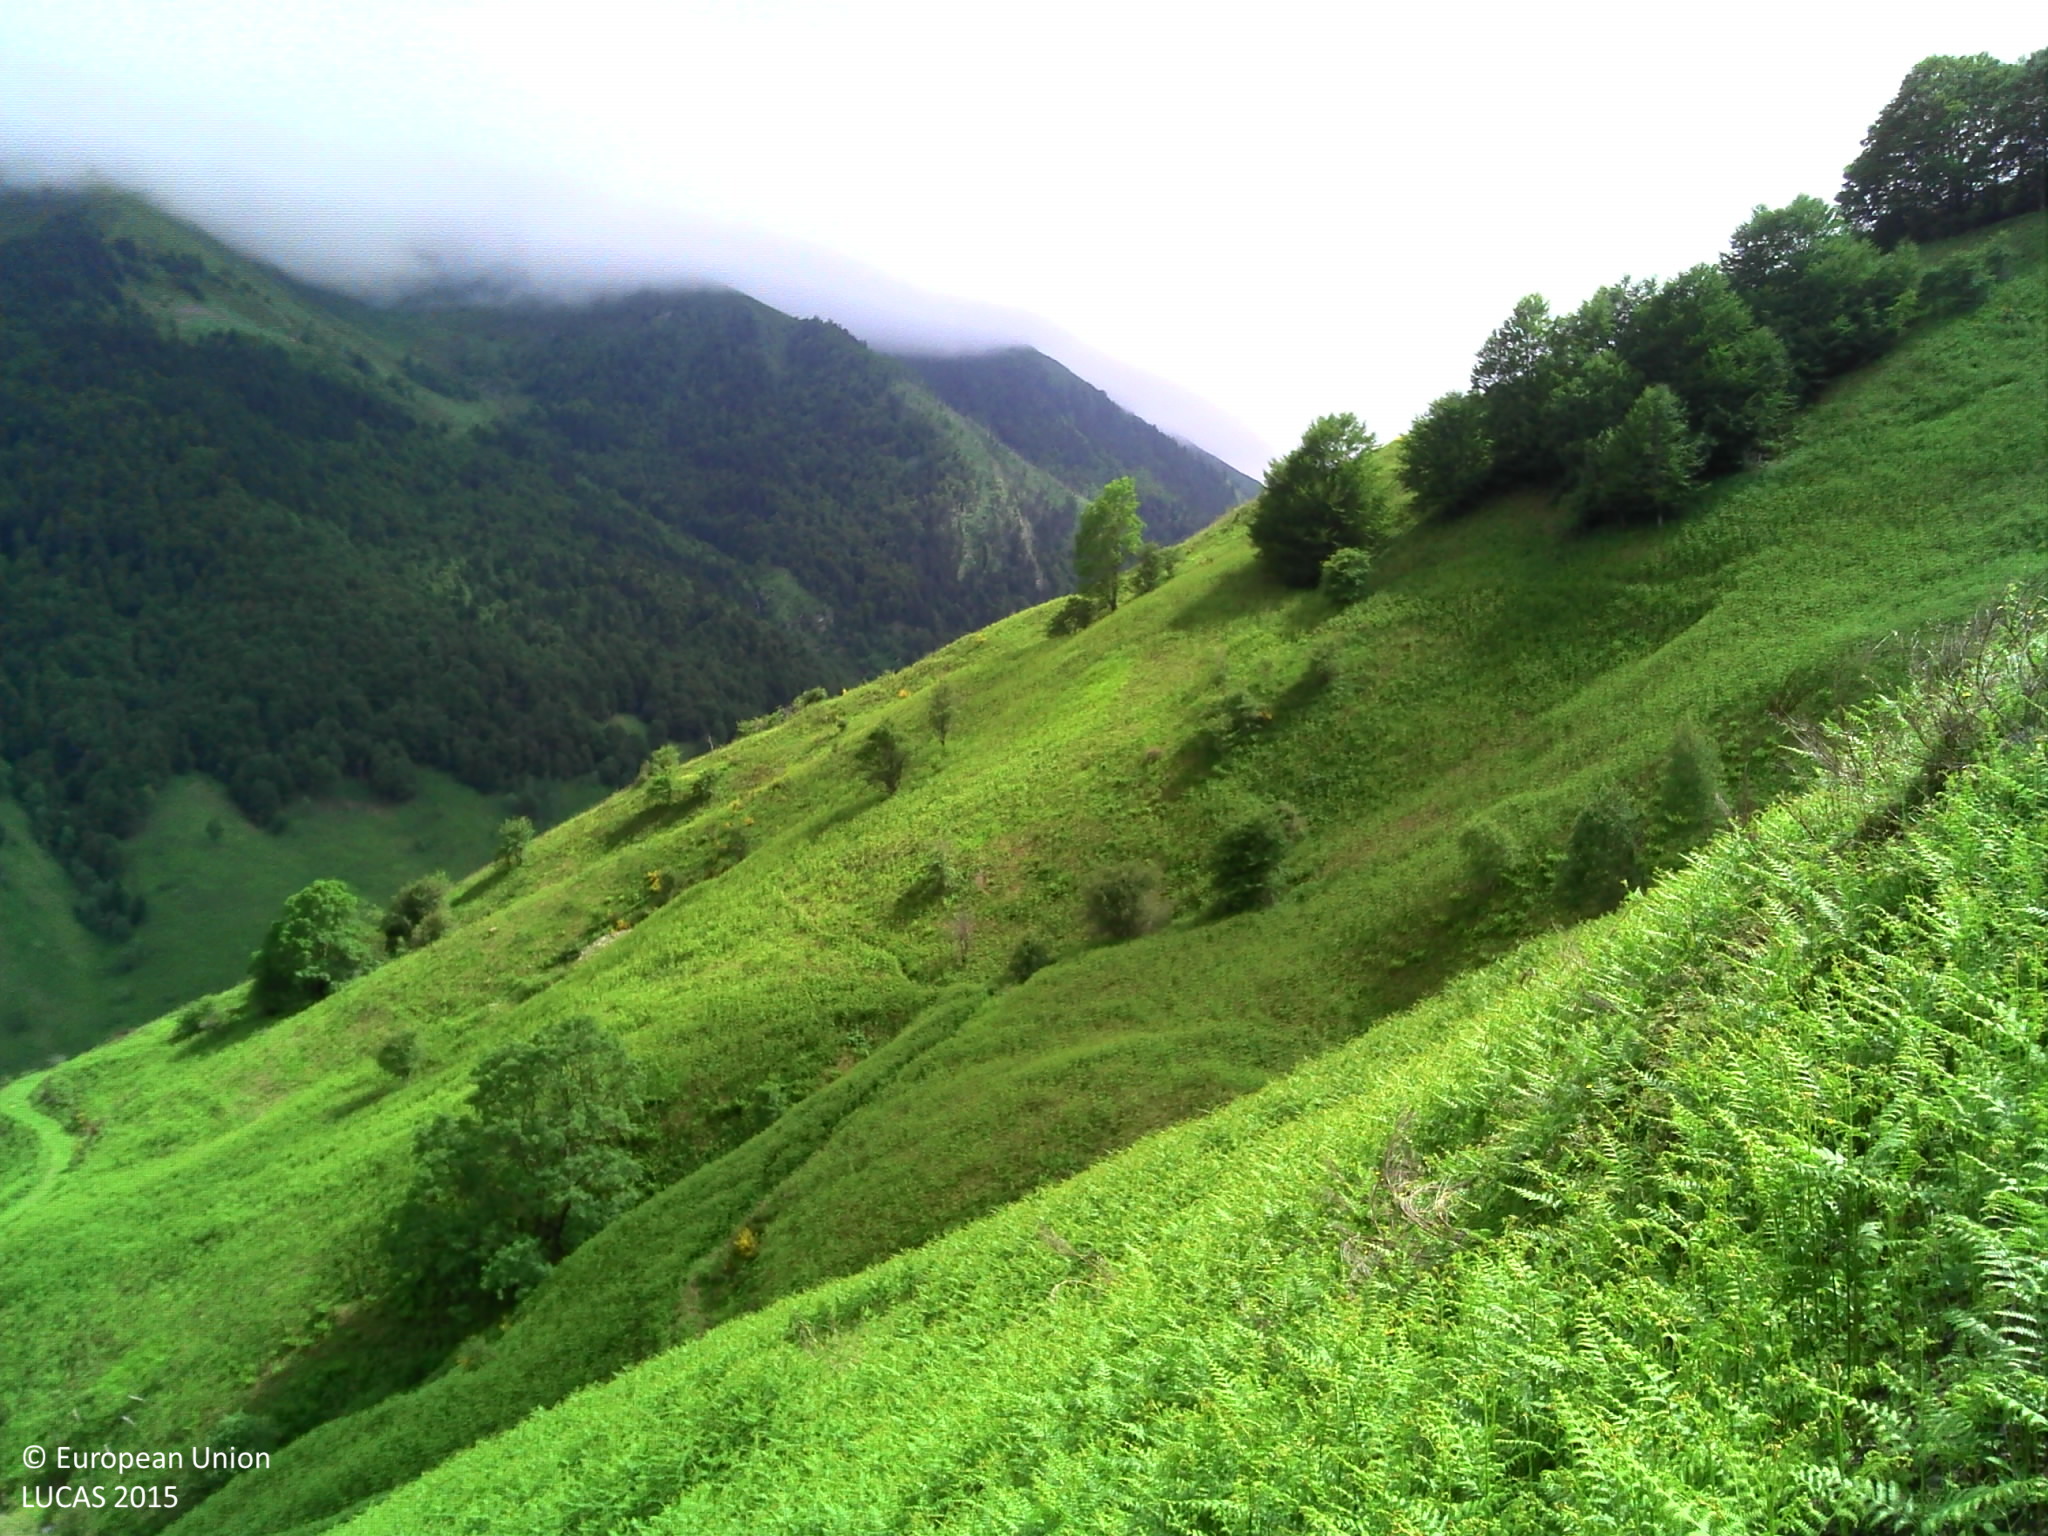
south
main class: Grassland
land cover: Grassland without tree/shrub cover
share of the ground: > 75 %
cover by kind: herbaceous plants 100 %
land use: Agriculture (excluding fallow land and kitchen gardens)
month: June
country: FR
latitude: 42.9123
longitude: -0.6262
